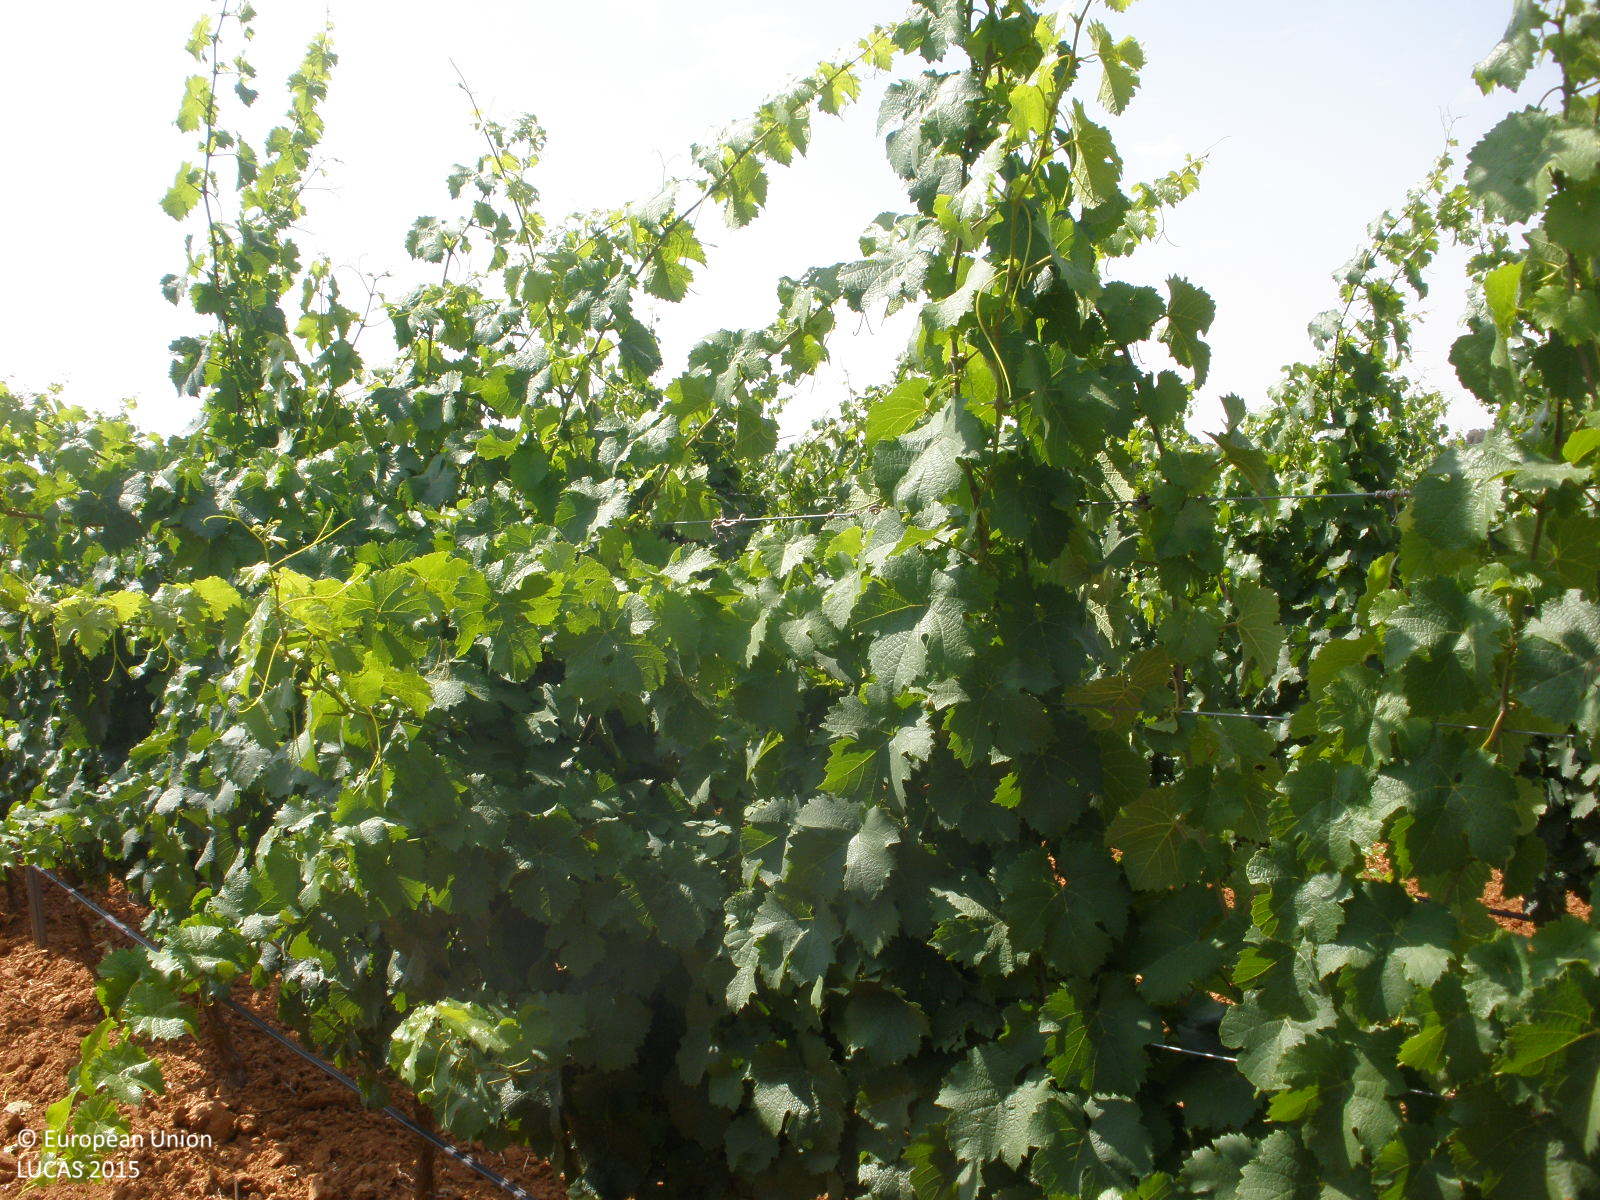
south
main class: Cropland
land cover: Vineyards
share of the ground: 50 - 75 %
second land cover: Other bare soil
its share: > 75 %
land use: Agriculture (excluding fallow land and kitchen gardens)
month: July
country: ES
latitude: 39.8362
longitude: -3.1458
